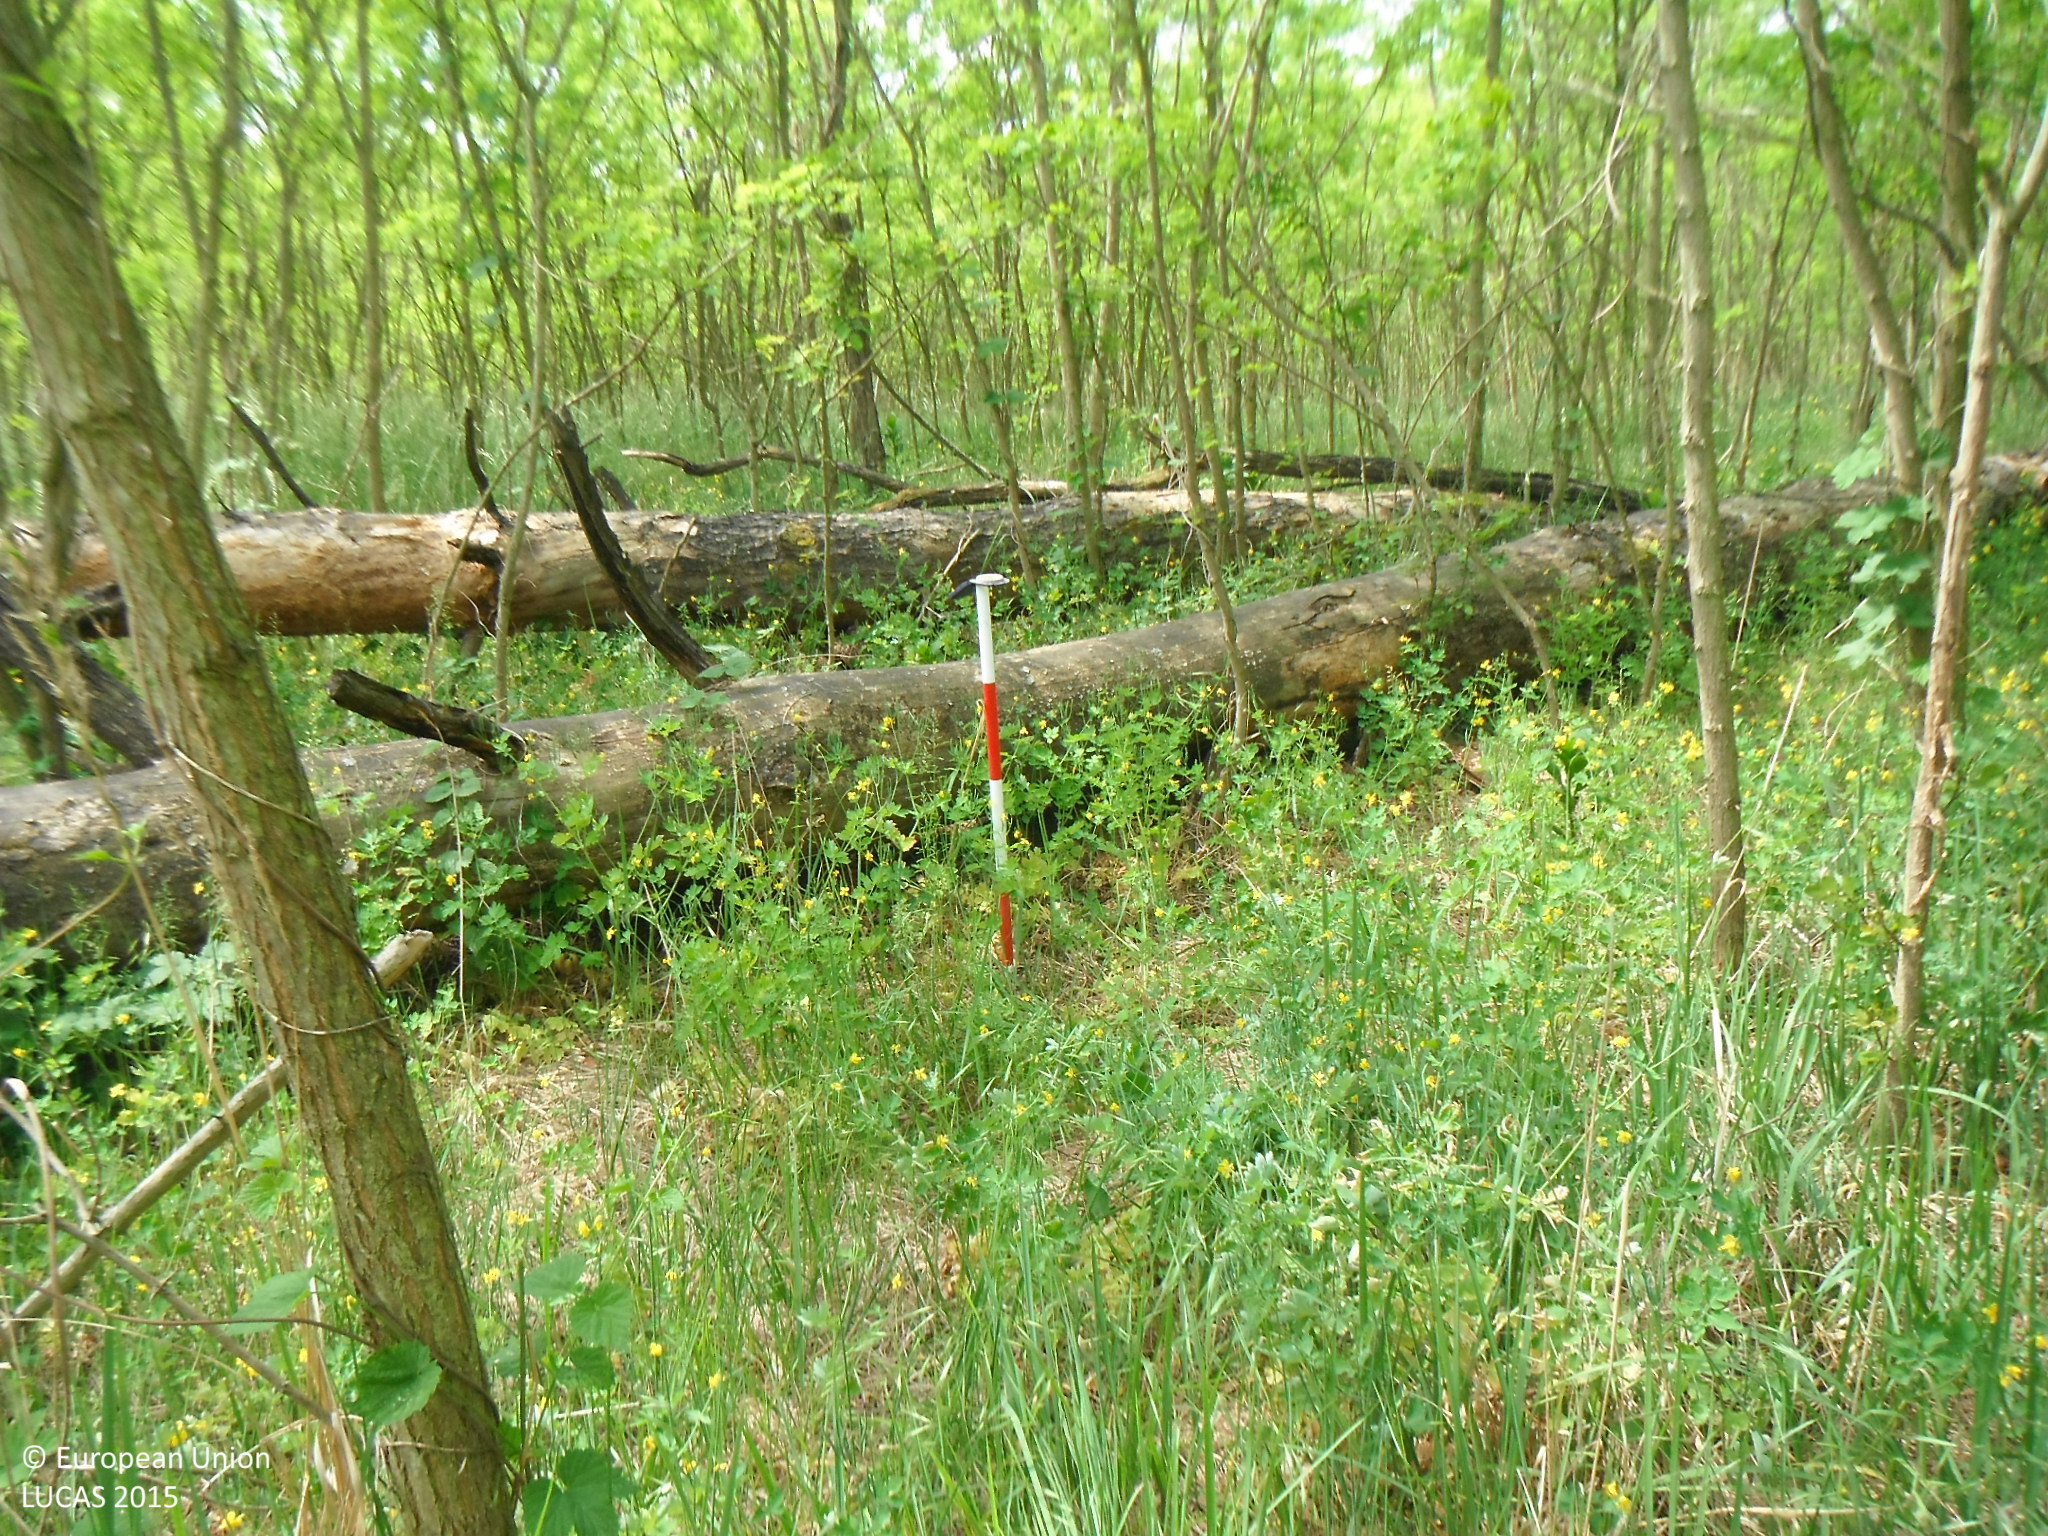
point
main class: Woodland
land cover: Broadleaved woodland
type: exotic forest
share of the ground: 50 - 75 %
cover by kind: broadleaved forest trees 60 %, shrubs 20 %, herbaceous plants 20 %
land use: Forestry
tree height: > 5 m
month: May
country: SK
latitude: 48.4218
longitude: 16.9127
